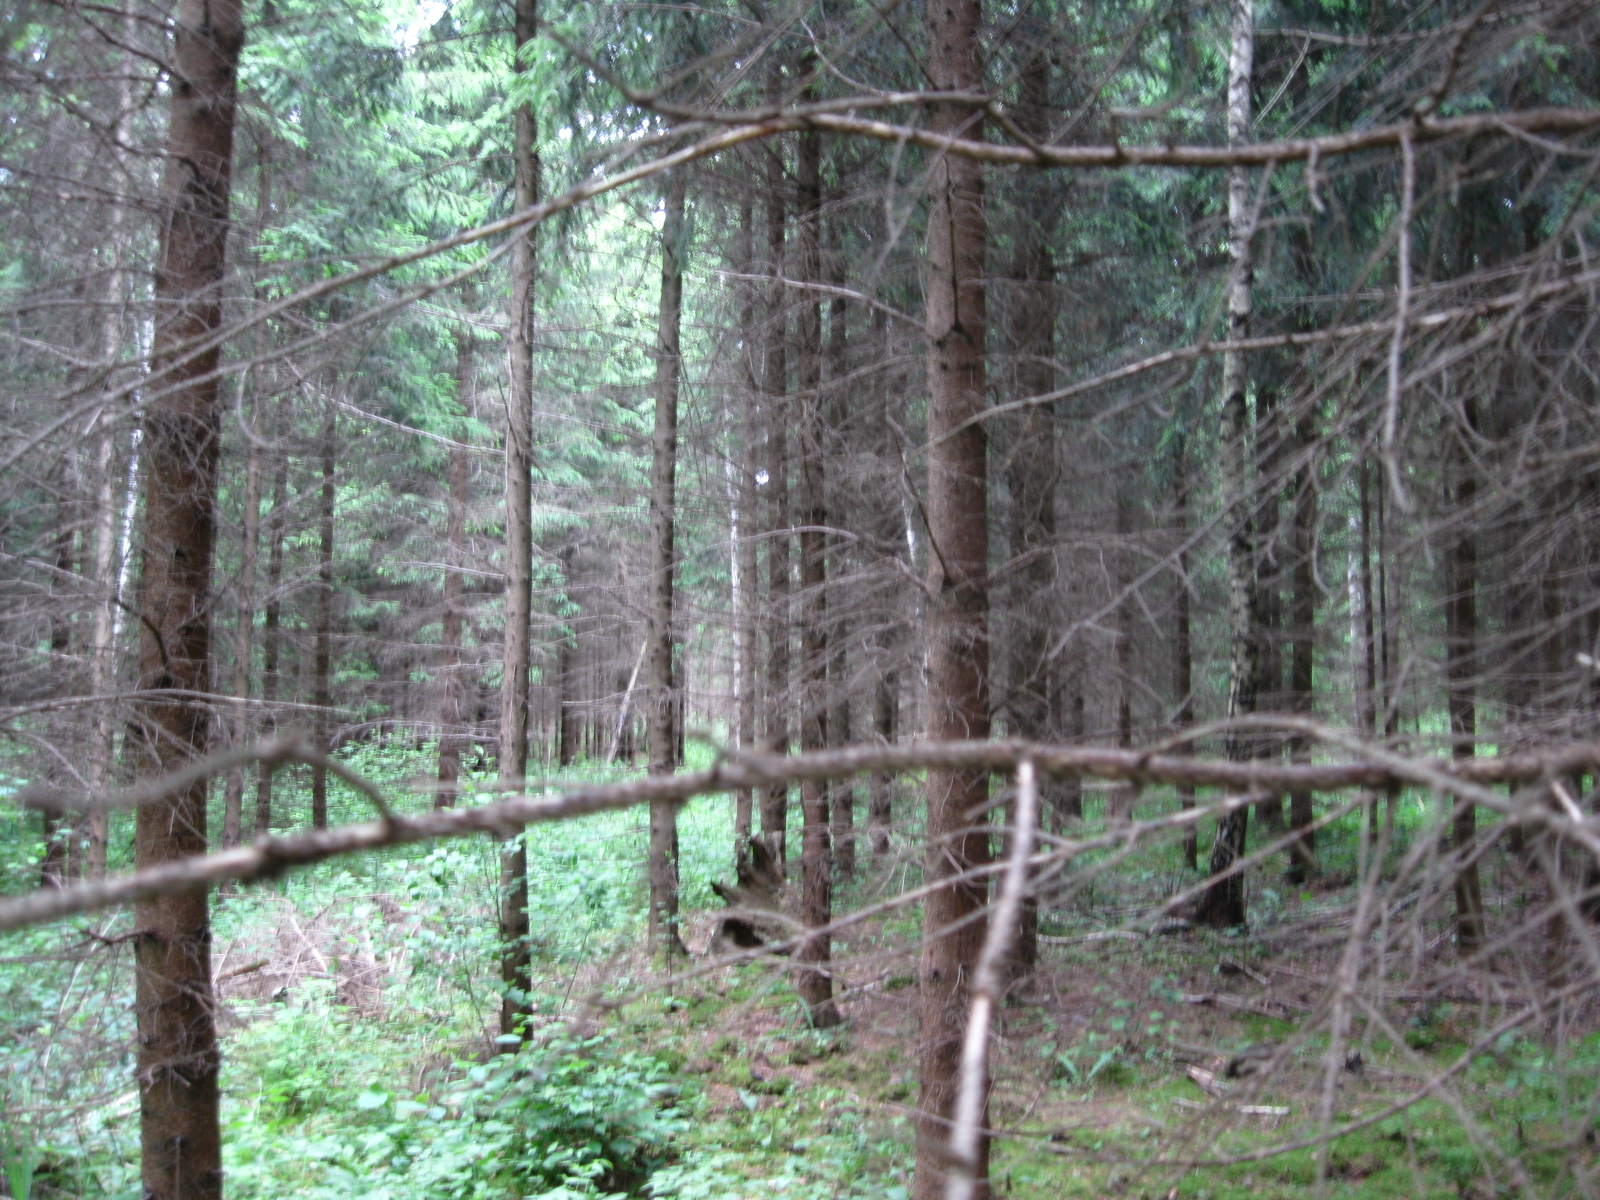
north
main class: Woodland
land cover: Spruce dominated coniferous woodland
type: hemiboreal forest and nemoral coniferous forest and mixed broadleaved-coniferous forest
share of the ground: > 75 %
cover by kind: coniferous forest trees 80 %, herbaceous plants 10 %, lichens and mosses 5 %, unconsolidated bare surface 5 %
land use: Forestry
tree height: > 5 m
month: June
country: LT
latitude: 55.4847
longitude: 24.1930
